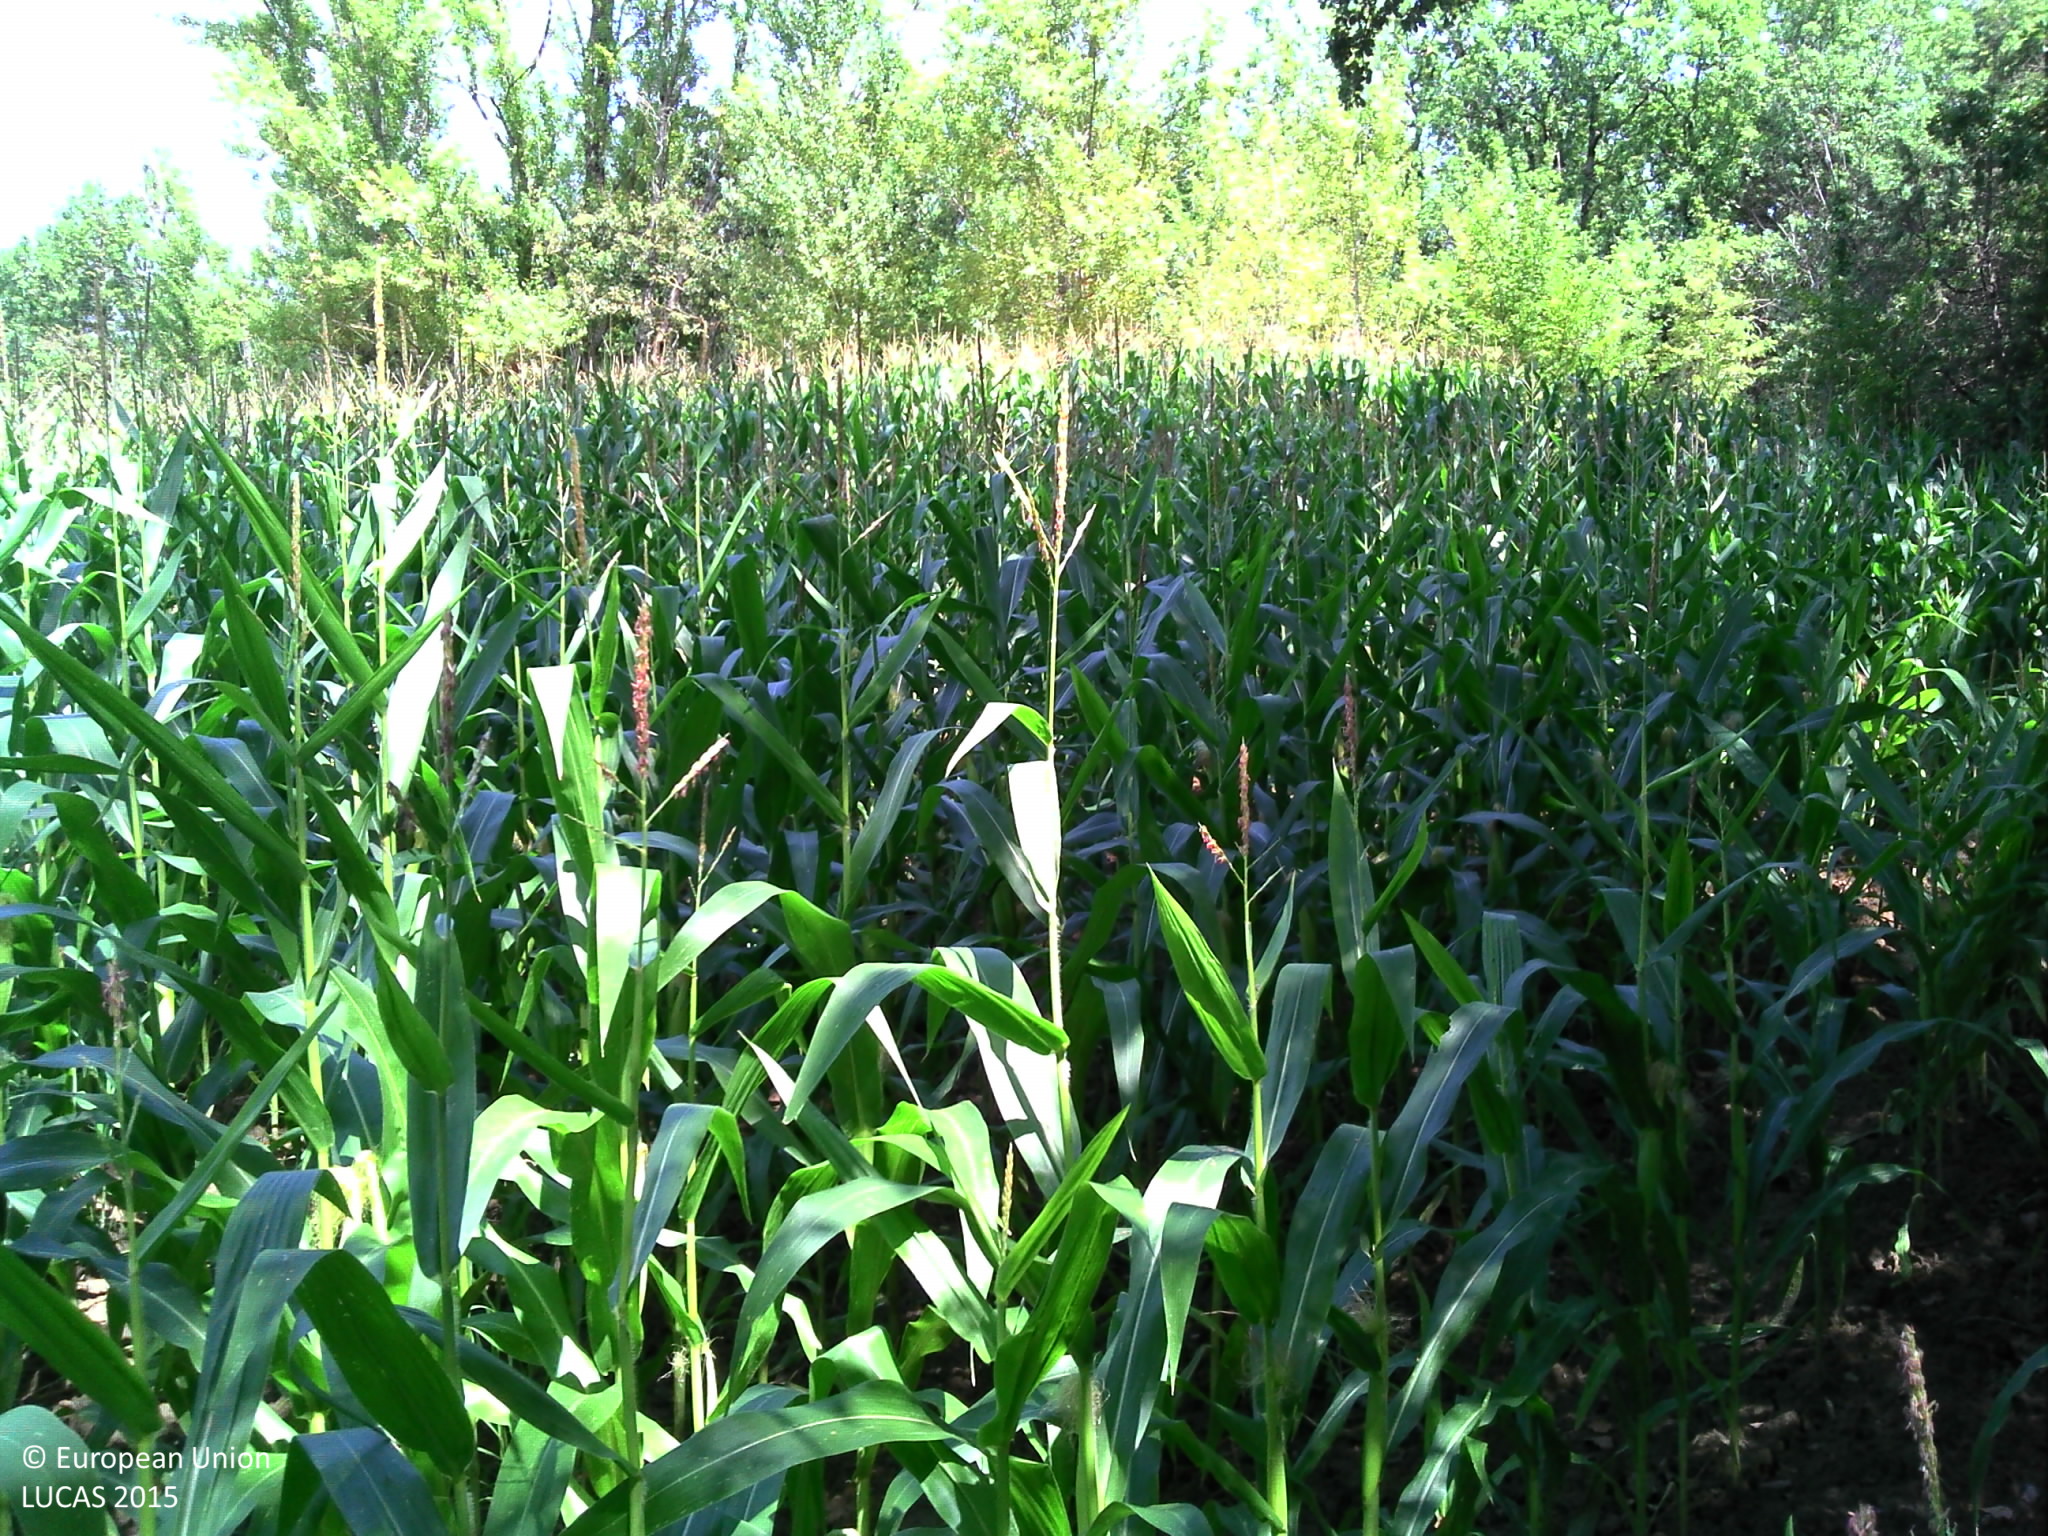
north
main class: Cropland
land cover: Maize
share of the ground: > 75 %
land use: Agriculture (excluding fallow land and kitchen gardens)
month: August
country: FR
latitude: 44.2189
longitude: 1.5006
